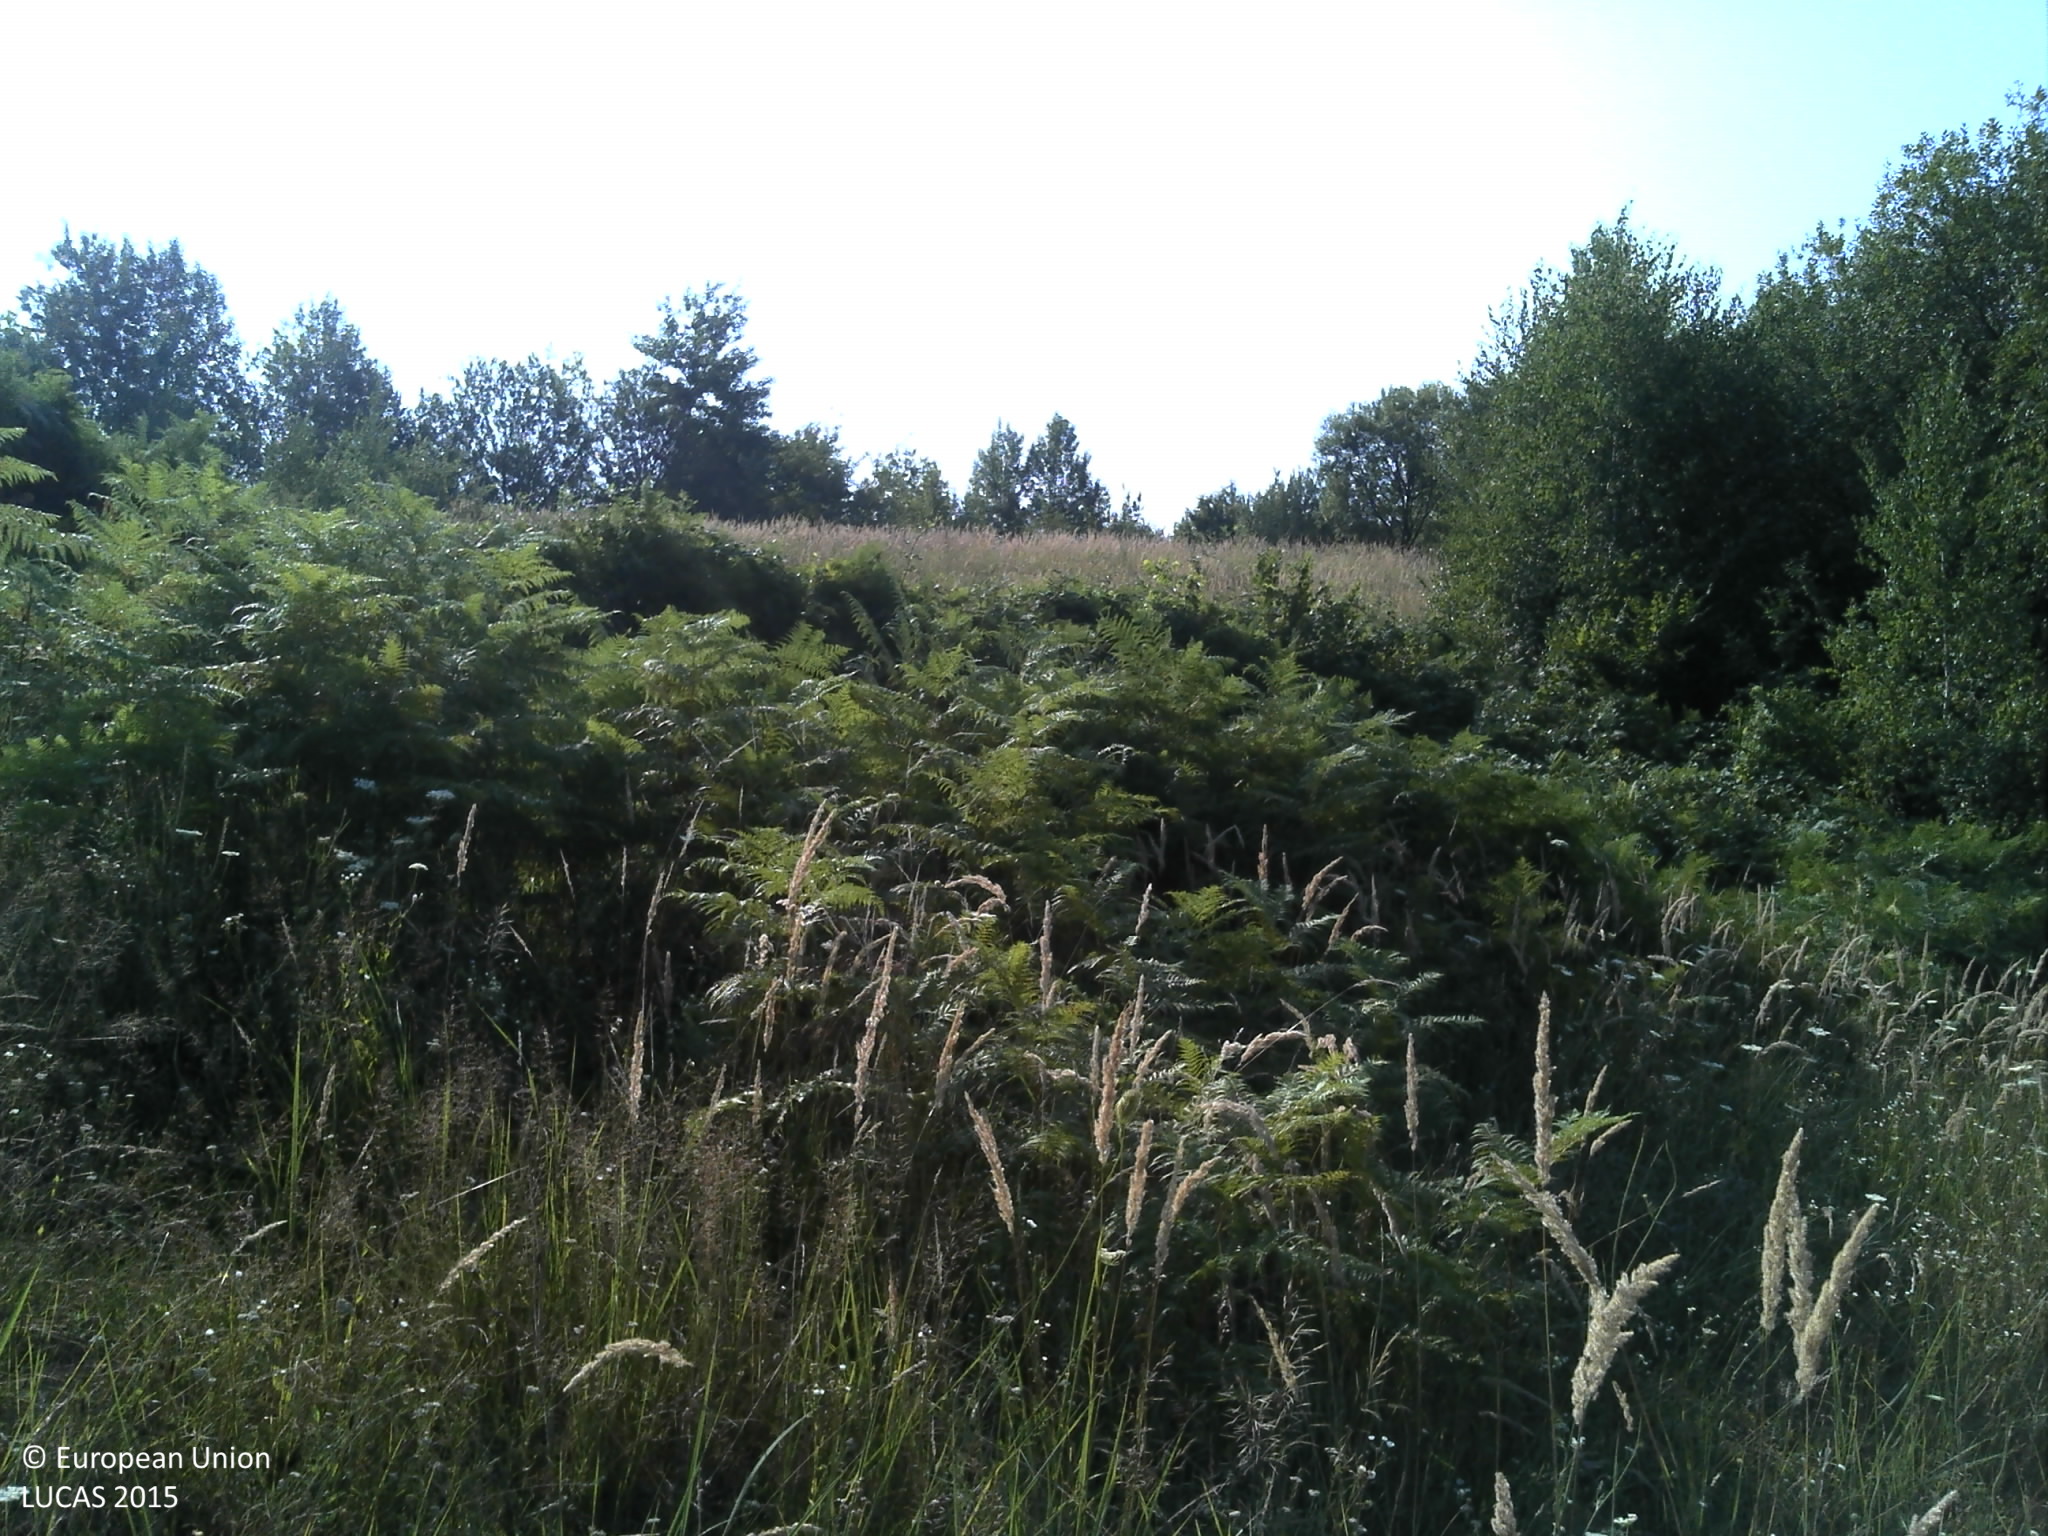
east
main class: Grassland
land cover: Spontaneously vegetated surfaces
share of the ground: > 75 %
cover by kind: herbaceous plants 100 %
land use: Semi-natural and natural areas not in use
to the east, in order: Spontaneously vegetated surfaces; Broadleaved woodland
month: August
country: HR
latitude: 45.7228
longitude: 17.2865
